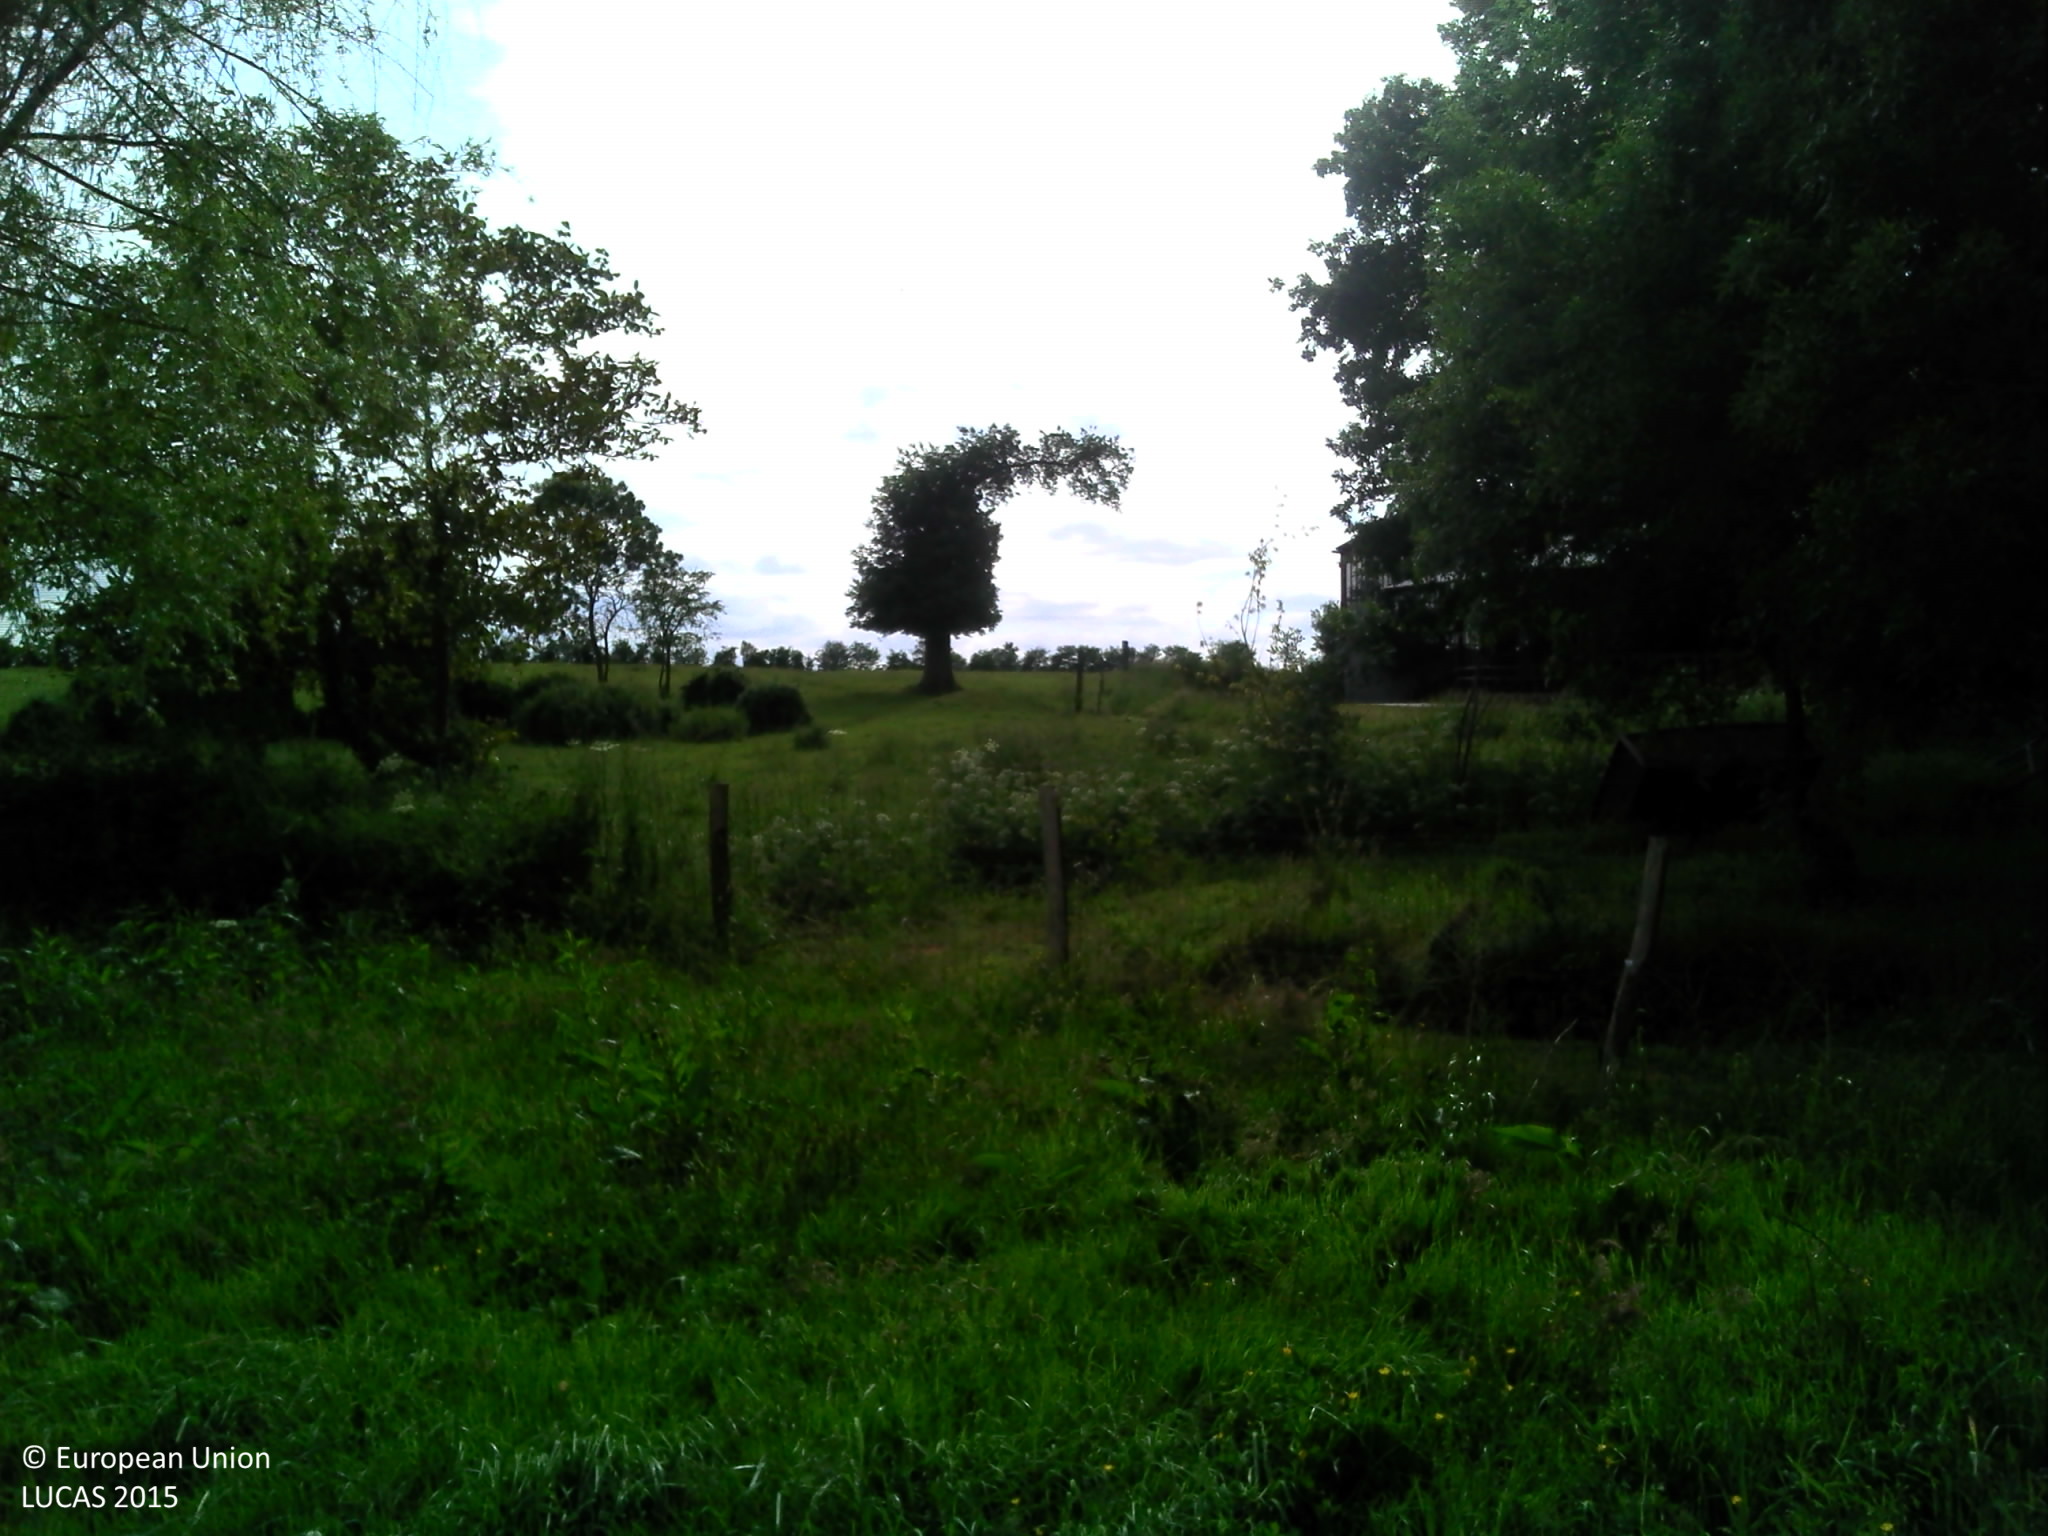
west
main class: Grassland
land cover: Grassland with sparse tree/shrub cover
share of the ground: > 75 %
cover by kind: herbaceous plants 90 %, broadleaved forest trees 5 %, shrubs 5 %
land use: Residential
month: May
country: FR
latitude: 46.9967
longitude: -1.2013
